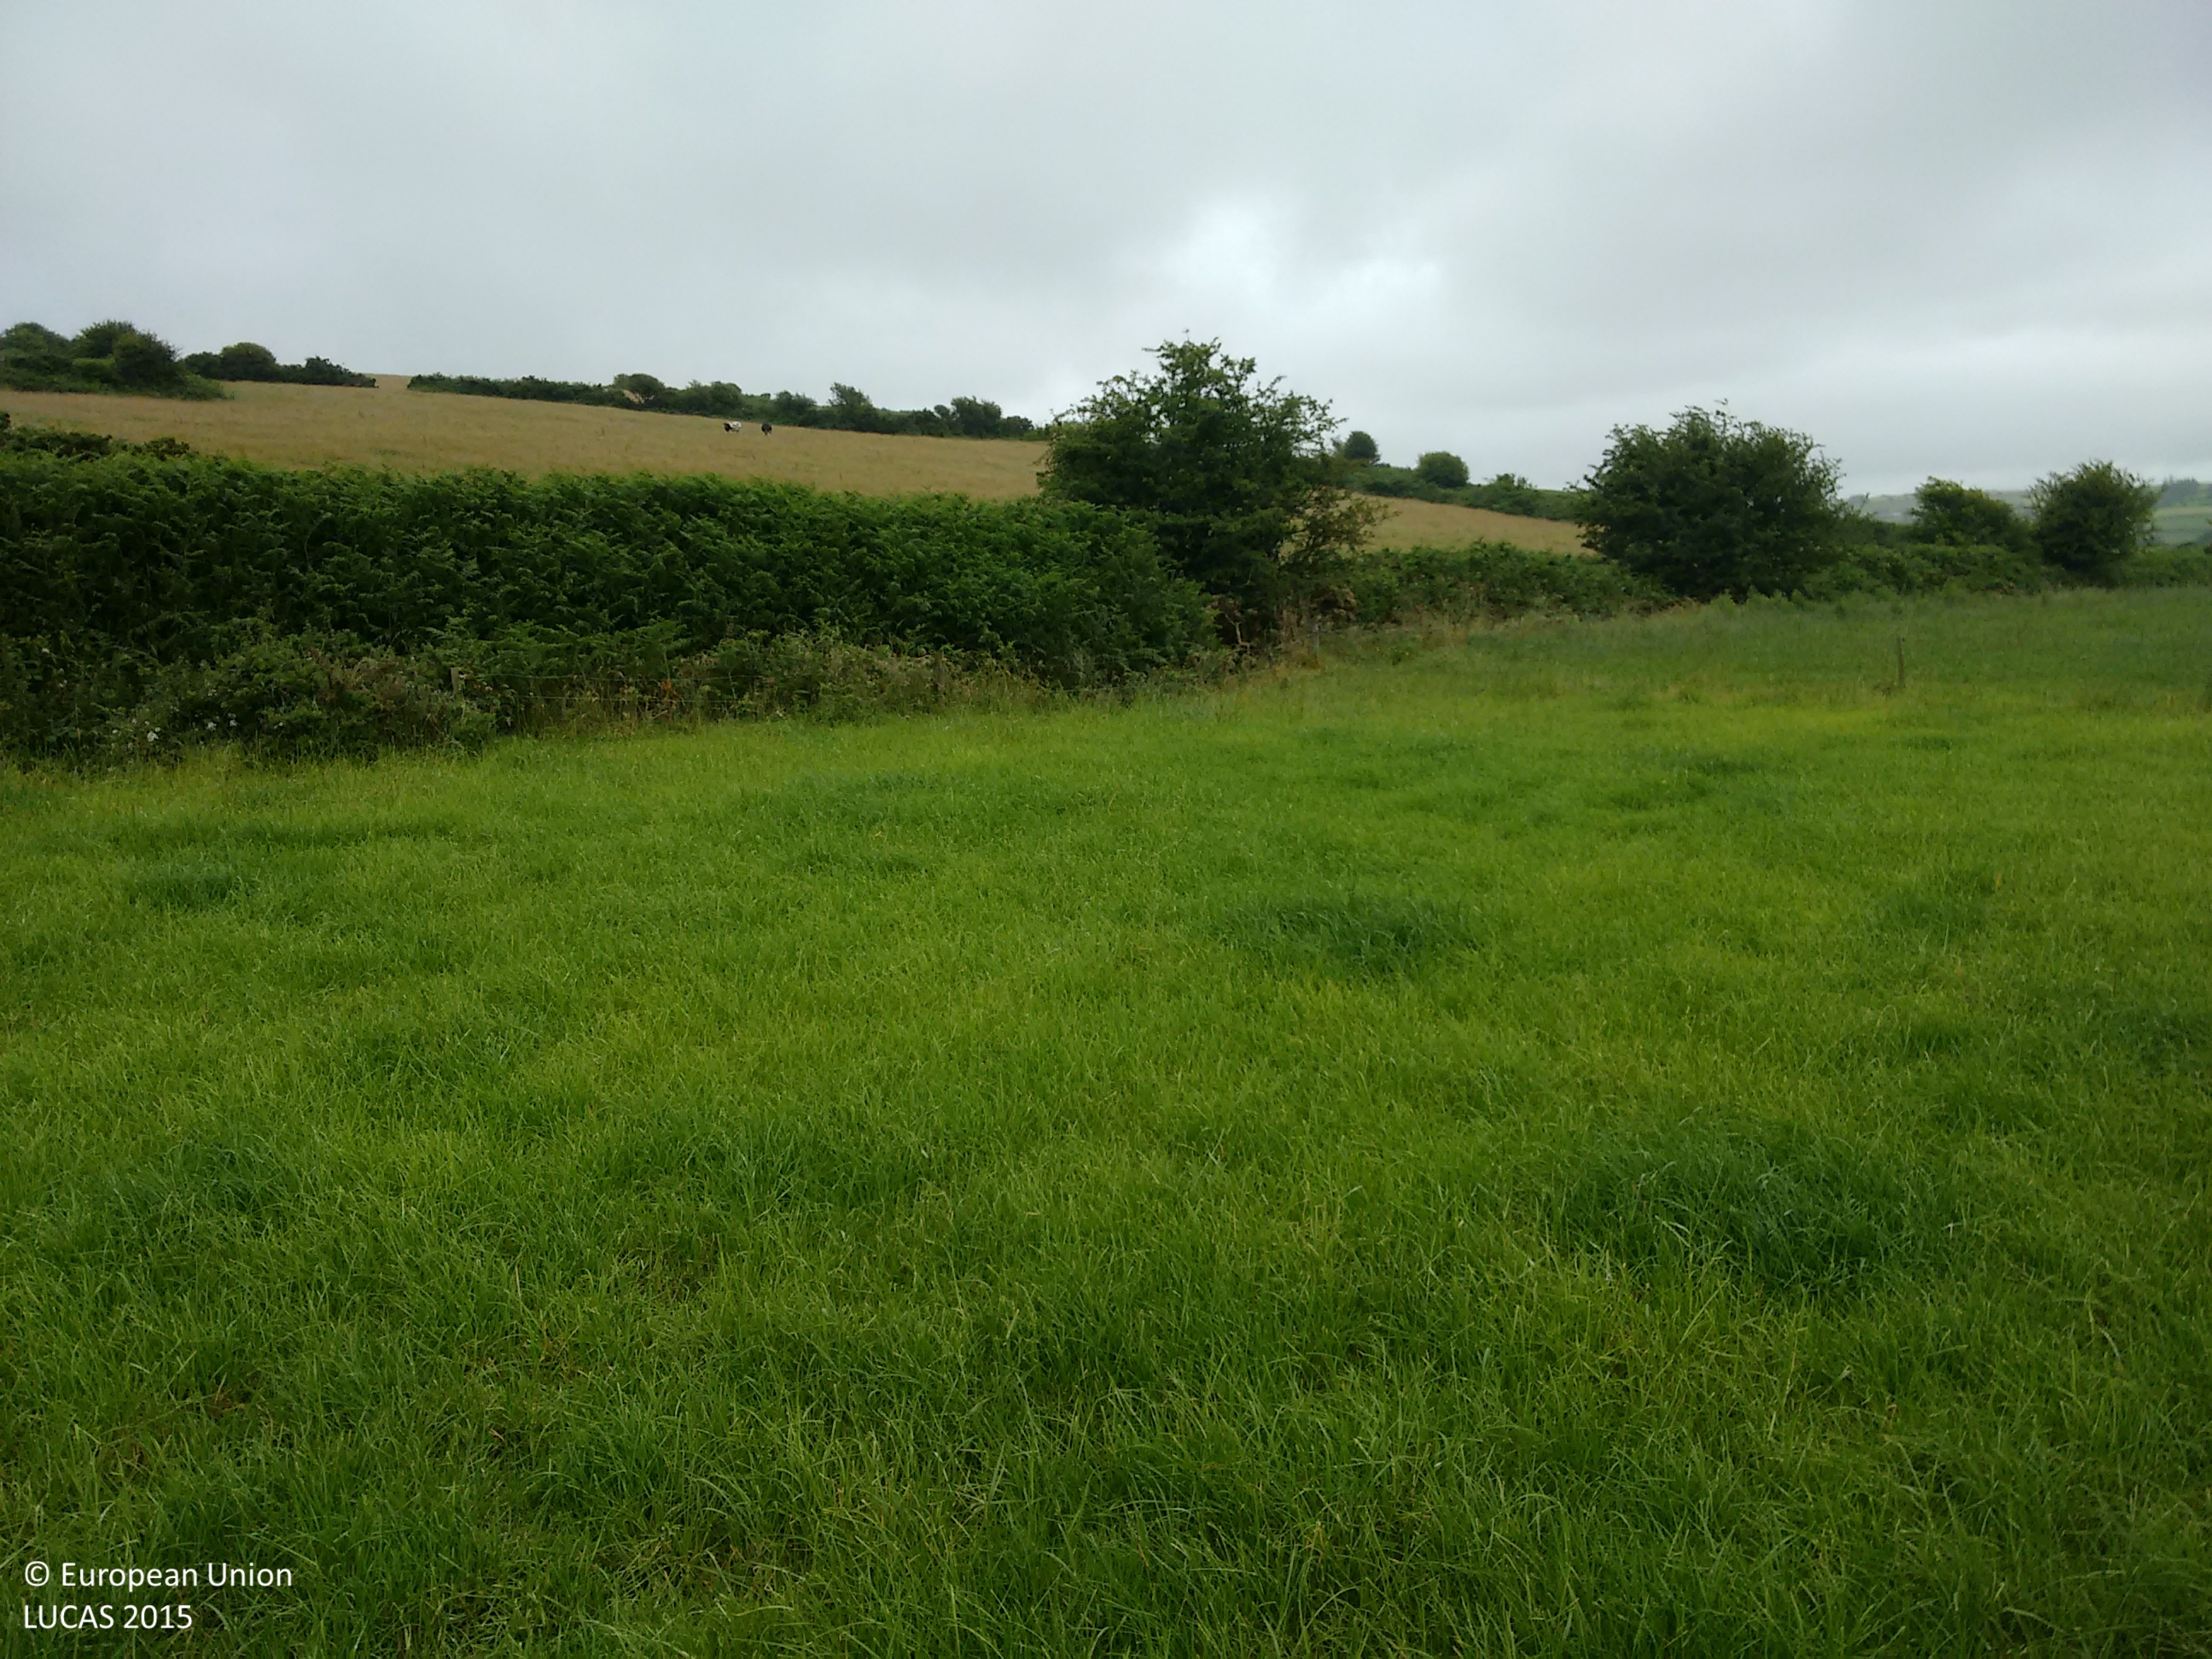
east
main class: Grassland
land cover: Grassland without tree/shrub cover
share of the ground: > 75 %
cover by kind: herbaceous plants 95 %, shrubs 5 %
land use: Agriculture (excluding fallow land and kitchen gardens)
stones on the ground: < 10 %
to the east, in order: Grassland without tree/shrub cover; Fences; Ditches and canals; Abandoned hedges; Grassland without tree/shrub cover; Abandoned hedges; Grassland without tree/shrub cover; Abandoned hedges; Grassland without tree/shrub cover
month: July
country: IE
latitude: 51.6512
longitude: -9.0175
